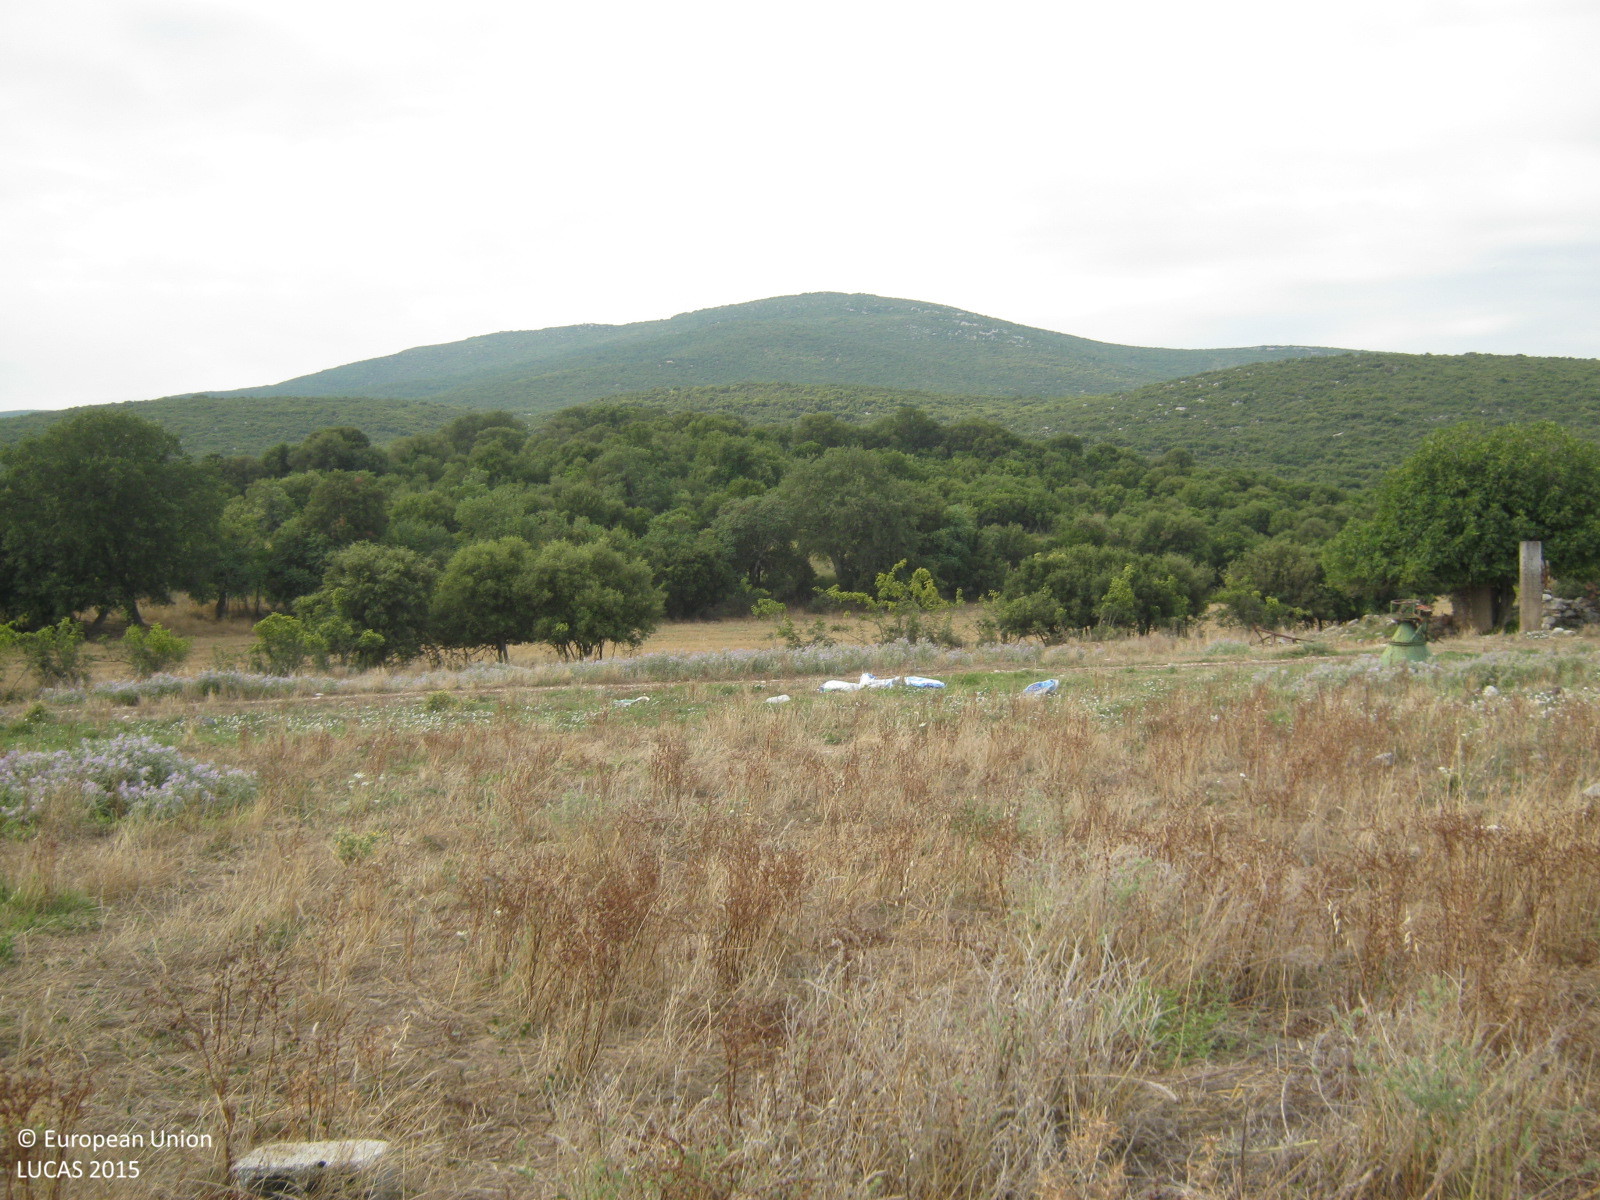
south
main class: Grassland
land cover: Grassland without tree/shrub cover
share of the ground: > 75 %
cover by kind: herbaceous plants 100 %
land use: Agriculture (excluding fallow land and kitchen gardens)
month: July
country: GR
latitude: 39.1722
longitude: 22.6372
